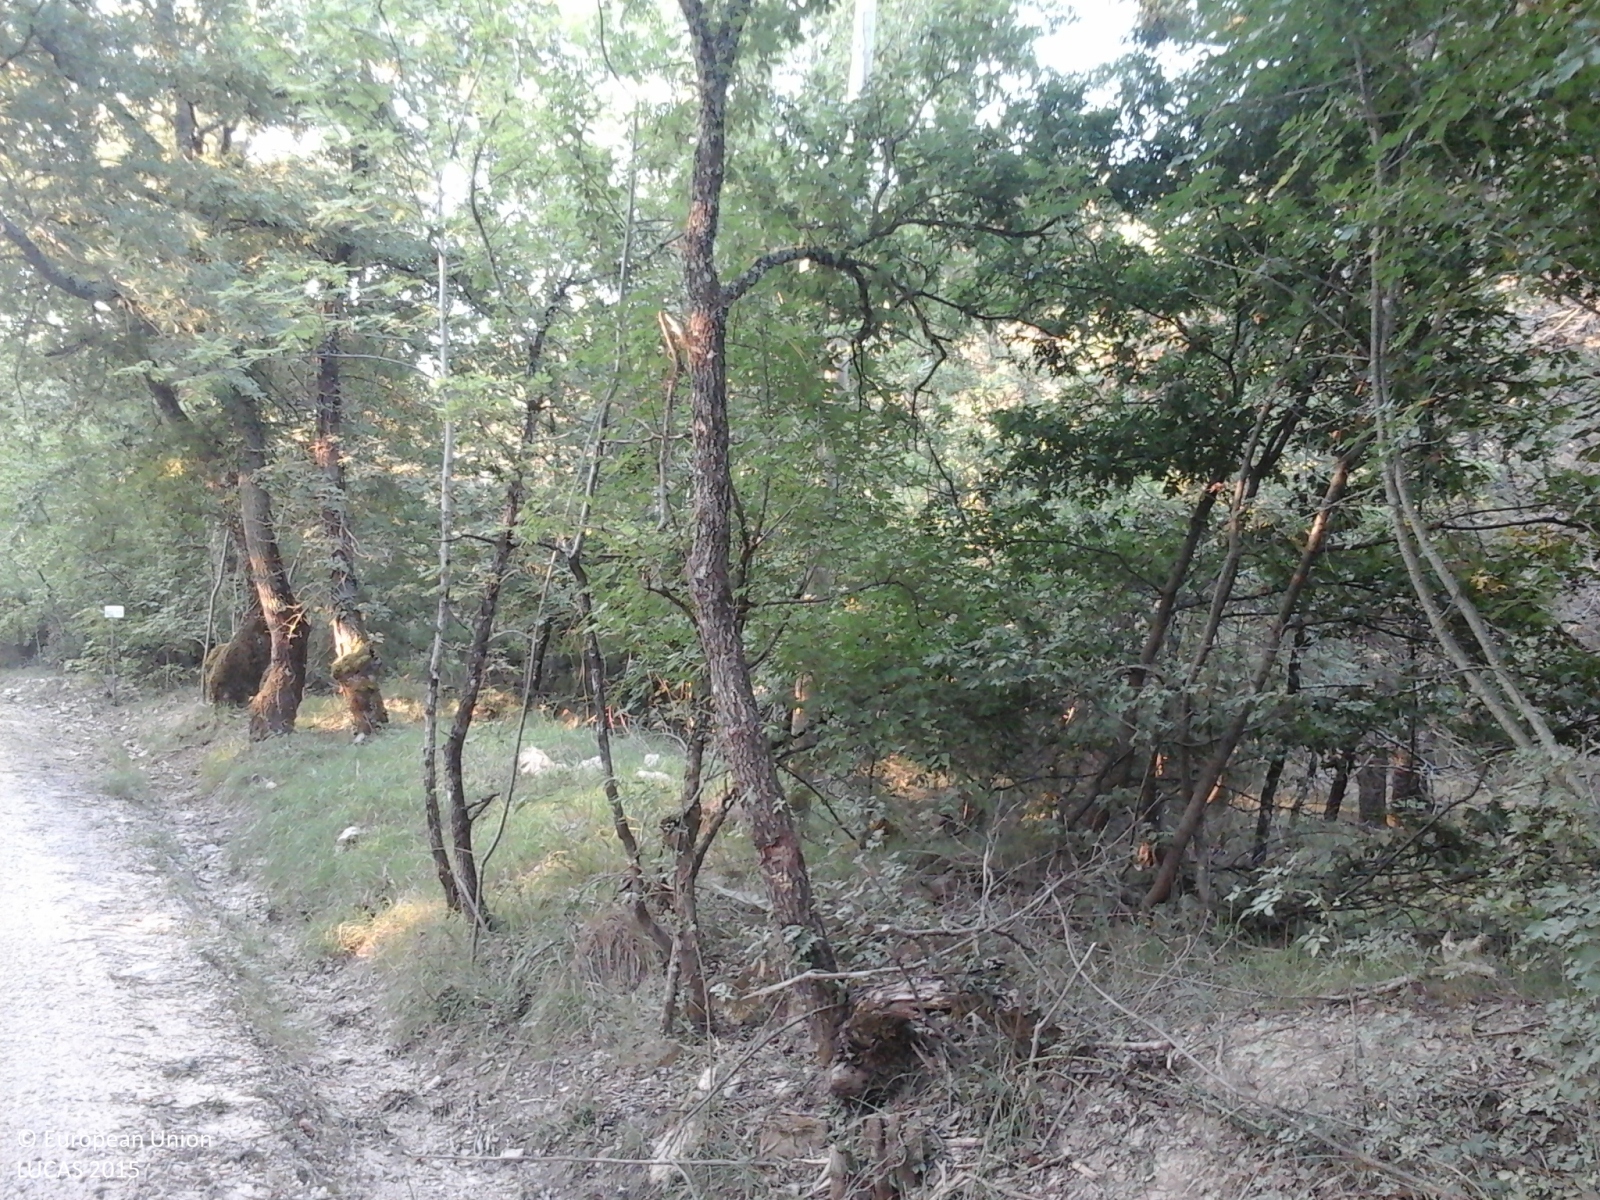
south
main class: Woodland
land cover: Broadleaved woodland
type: thermophilous deciduous forest
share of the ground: > 75 %
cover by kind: broadleaved forest trees 100 %
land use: Forestry
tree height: > 5 m
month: July
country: IT
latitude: 43.2618
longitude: 11.1177
